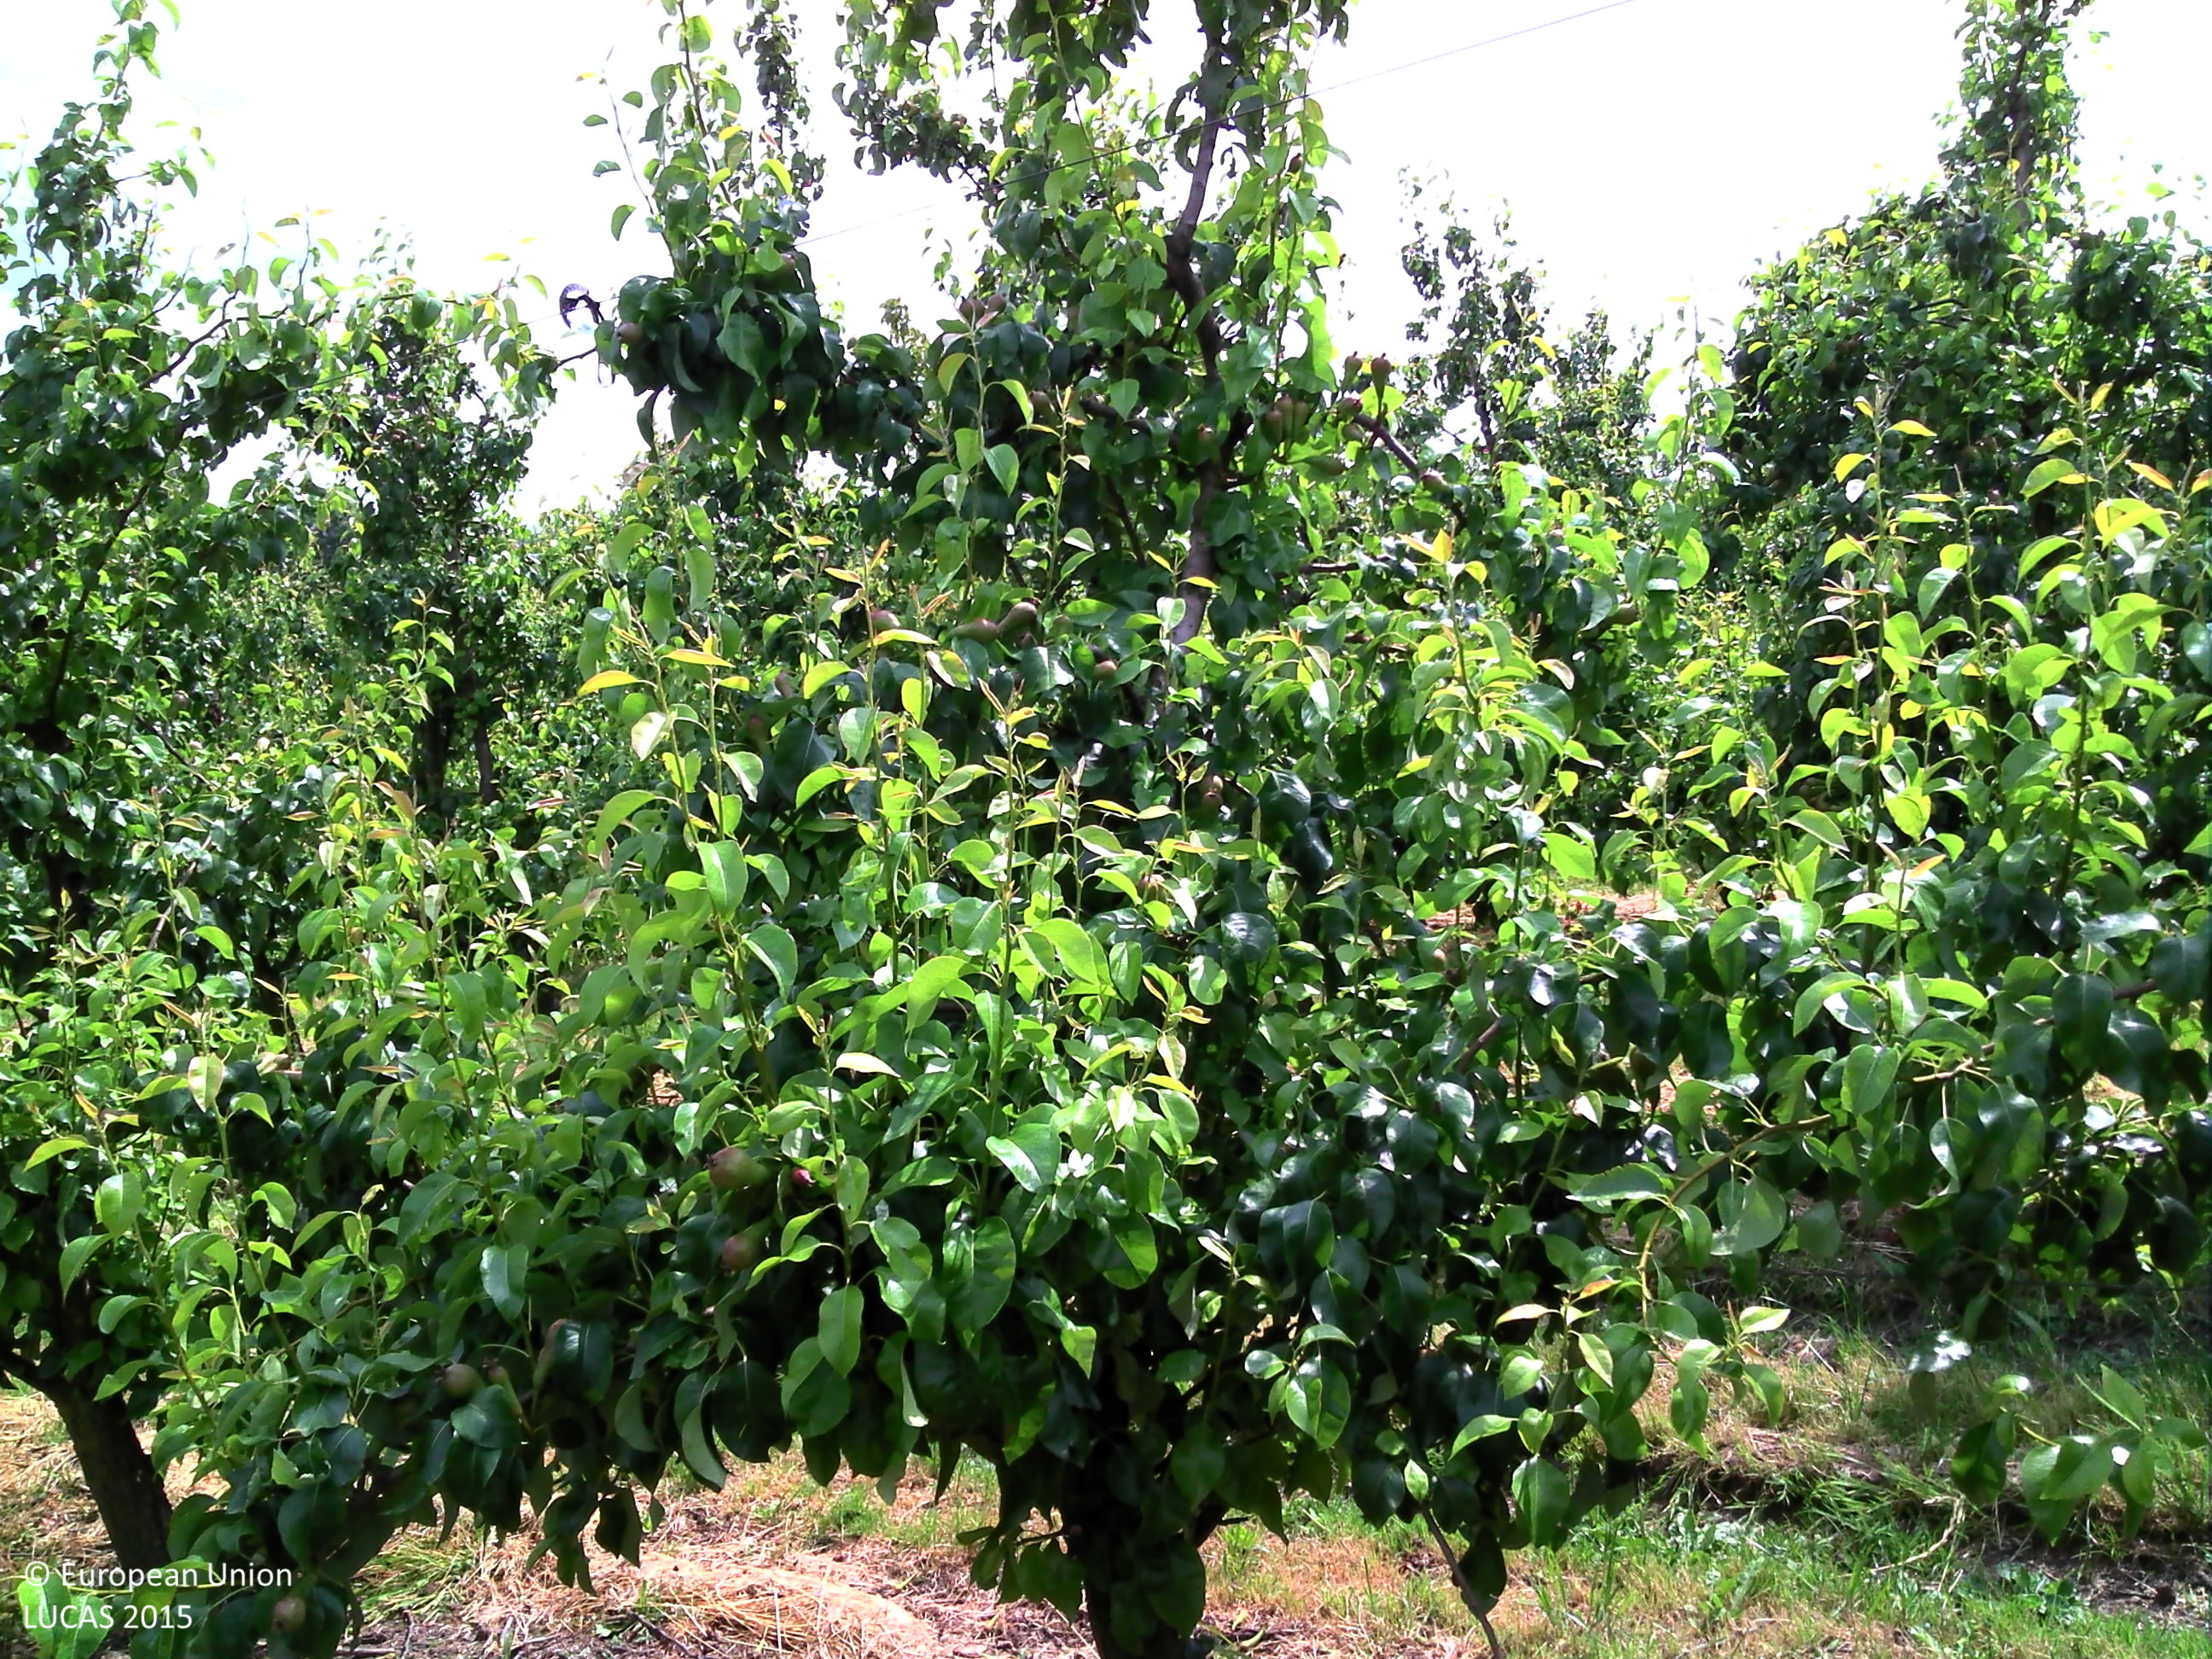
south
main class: Cropland
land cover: Pear fruit
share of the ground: 50 - 75 %
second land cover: Grassland without tree/shrub cover
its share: 25 - 50 %
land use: Agriculture (excluding fallow land and kitchen gardens)
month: June
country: BE
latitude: 50.7114
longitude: 5.5940
